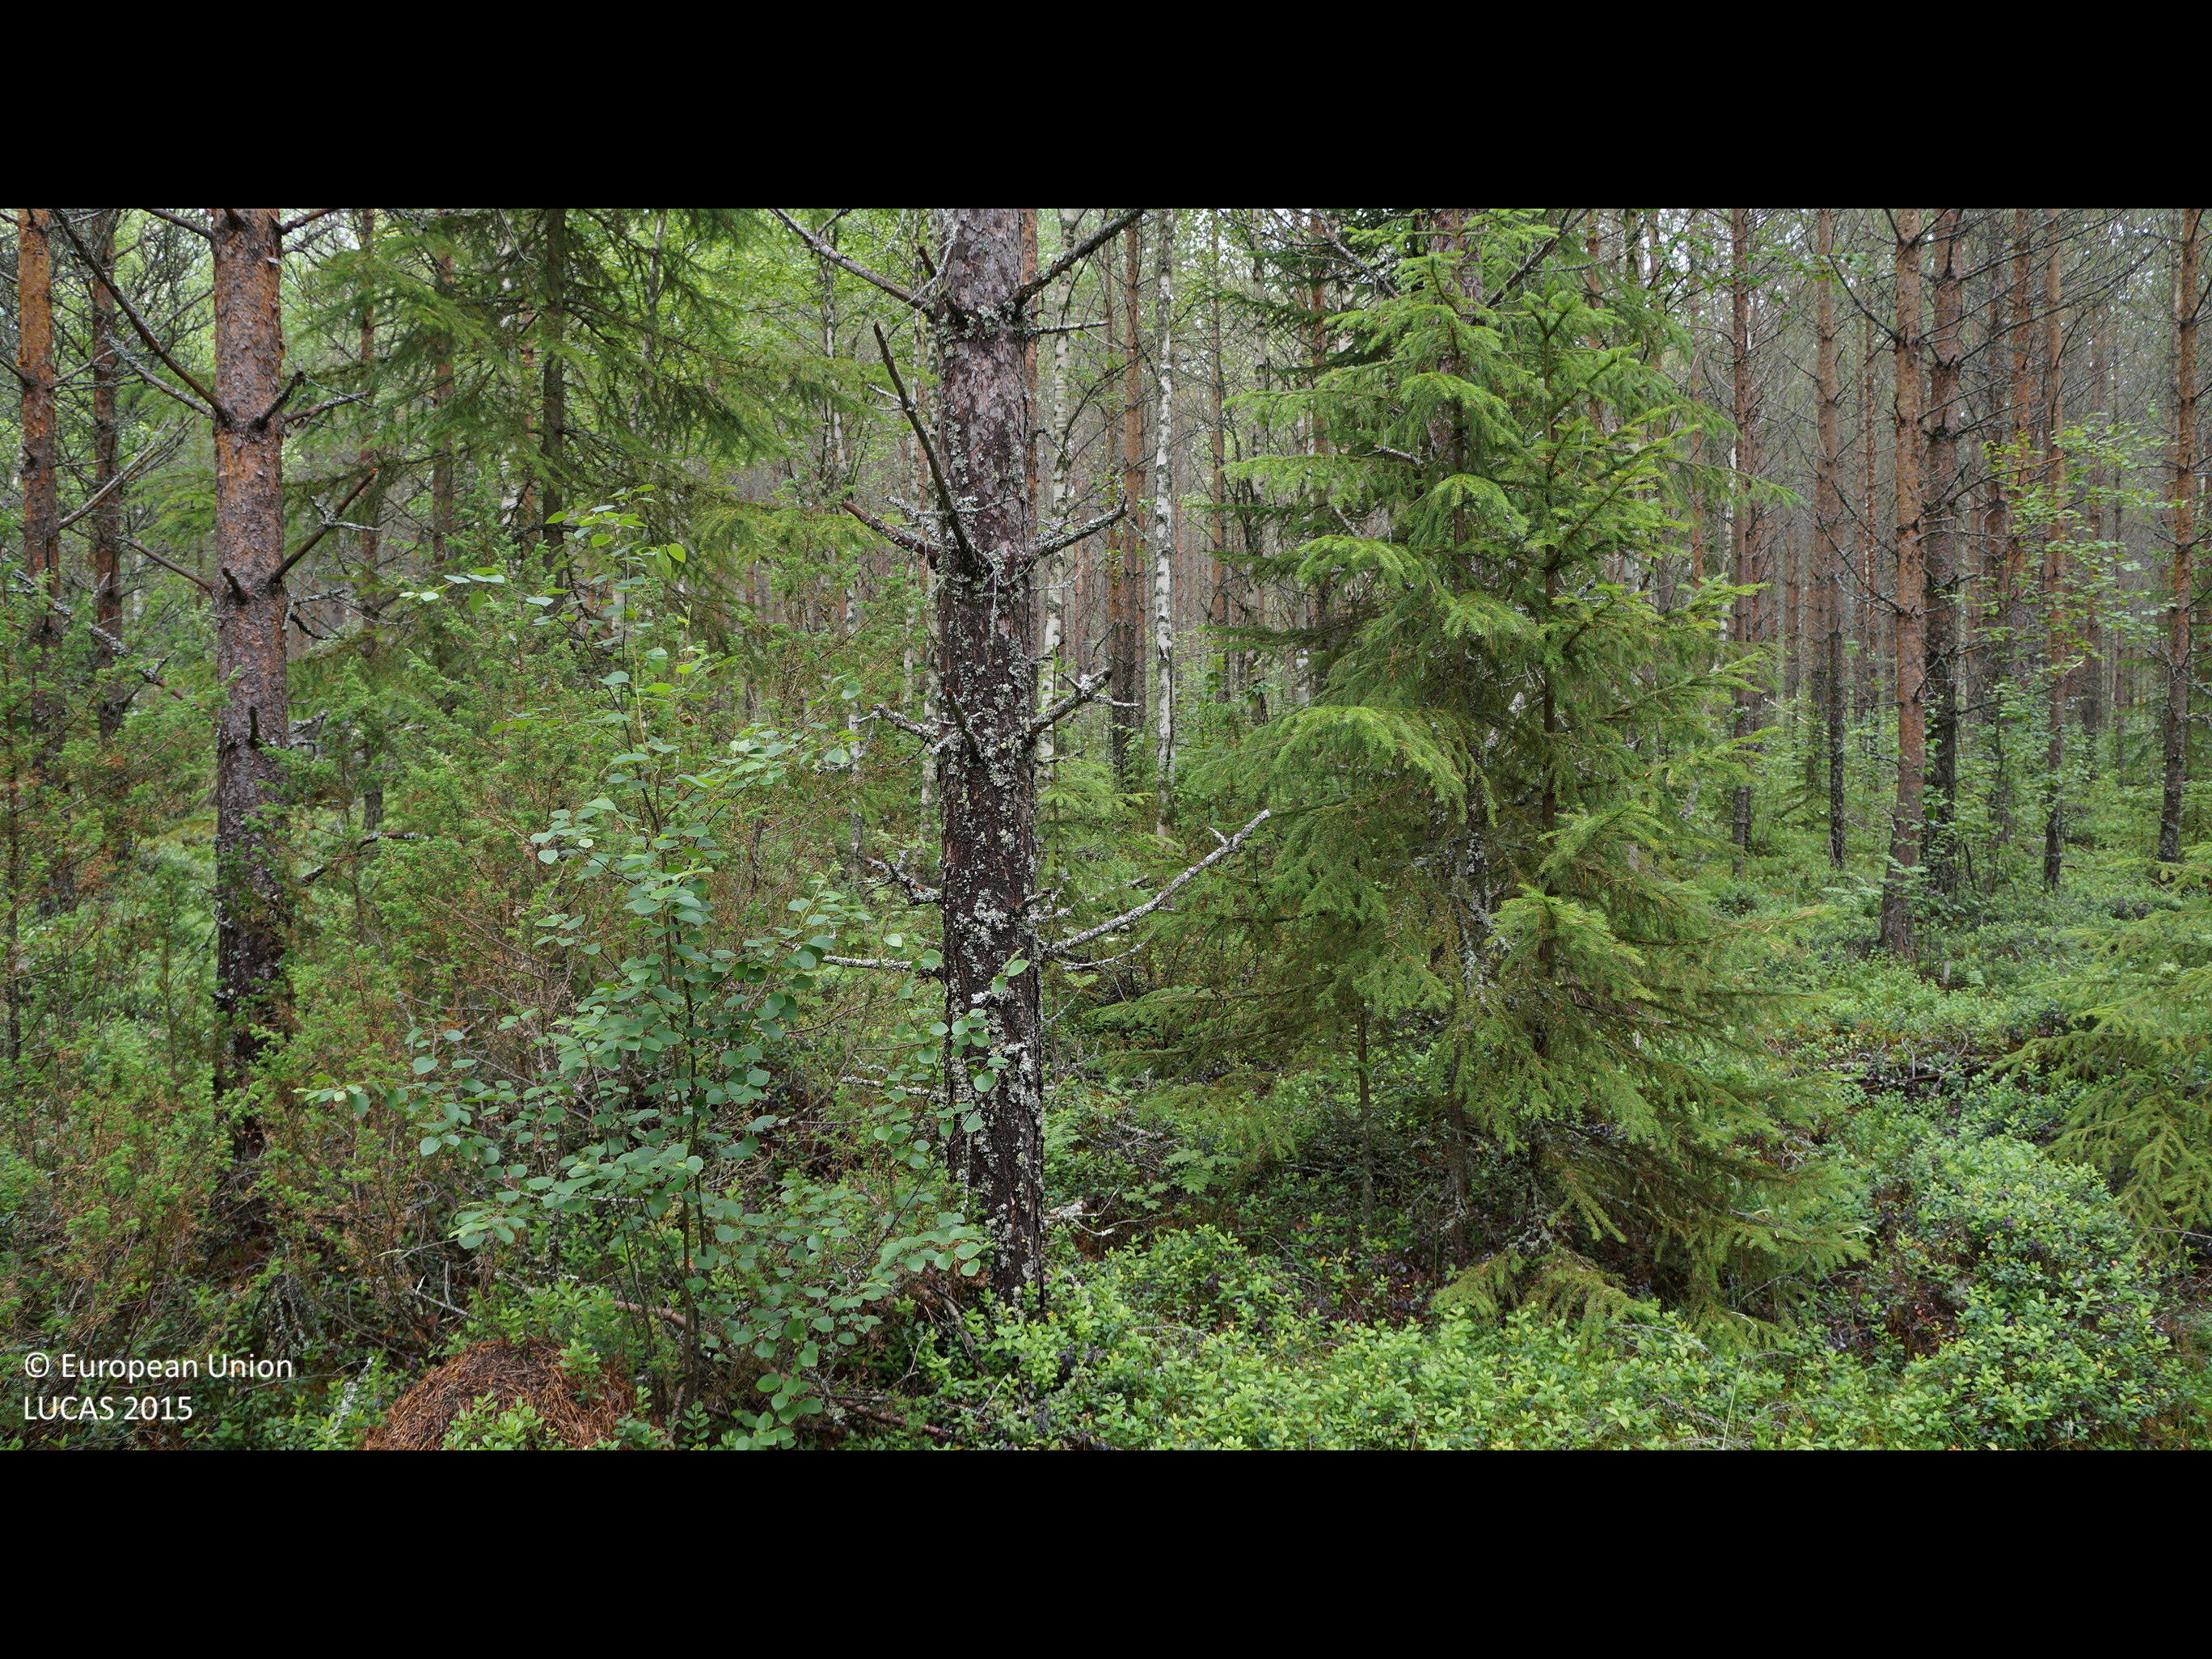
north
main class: Woodland
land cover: Pine dominated mixed woodland
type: boreal forest
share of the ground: 50 - 75 %
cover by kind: coniferous forest trees 40 %, broadleaved forest trees 20 %, shrubs 20 %, herbaceous plants 10 %, lichens and mosses 10 %
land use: Forestry
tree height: > 5 m
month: July
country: FI
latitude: 63.9922
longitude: 23.8186
